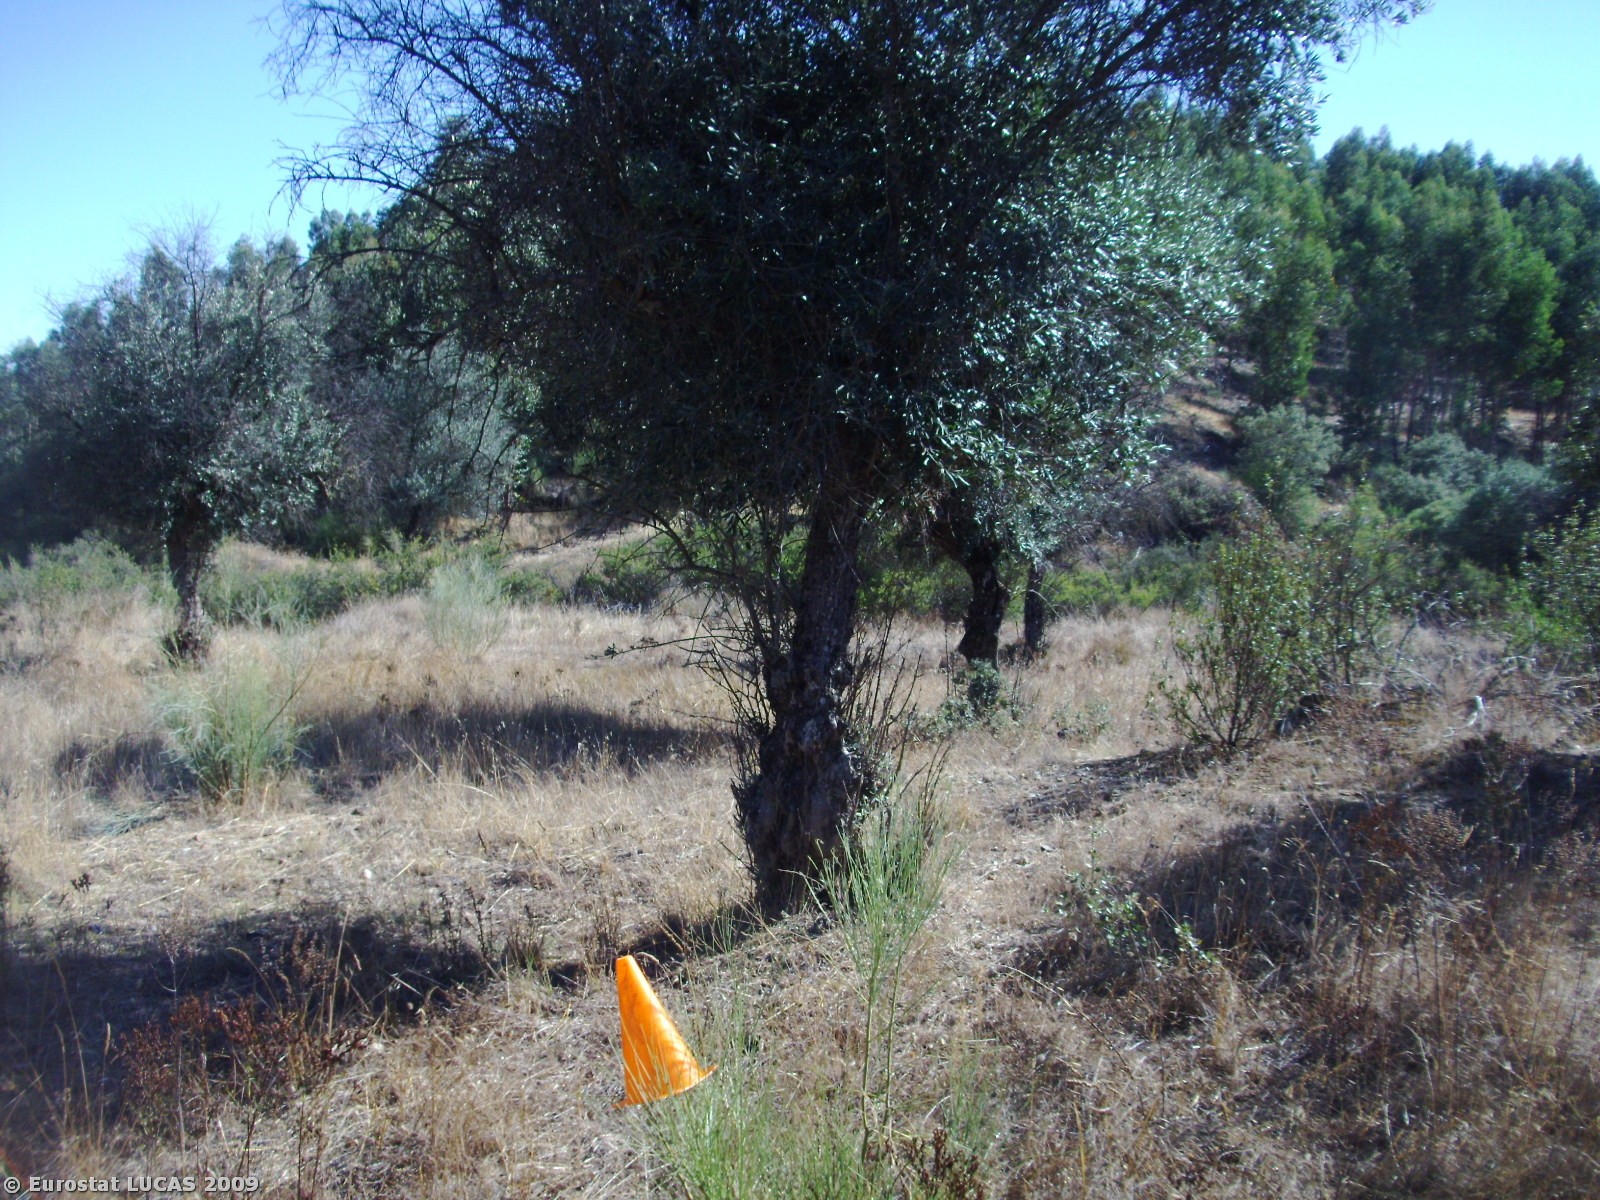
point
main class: Cropland
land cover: Olive groves
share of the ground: 25 - 50 %
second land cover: Spontaneously vegetated surfaces
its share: 50 - 75 %
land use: Agriculture (excluding fallow land and kitchen gardens)
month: May
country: PT
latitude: 39.7514
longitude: -7.4995
